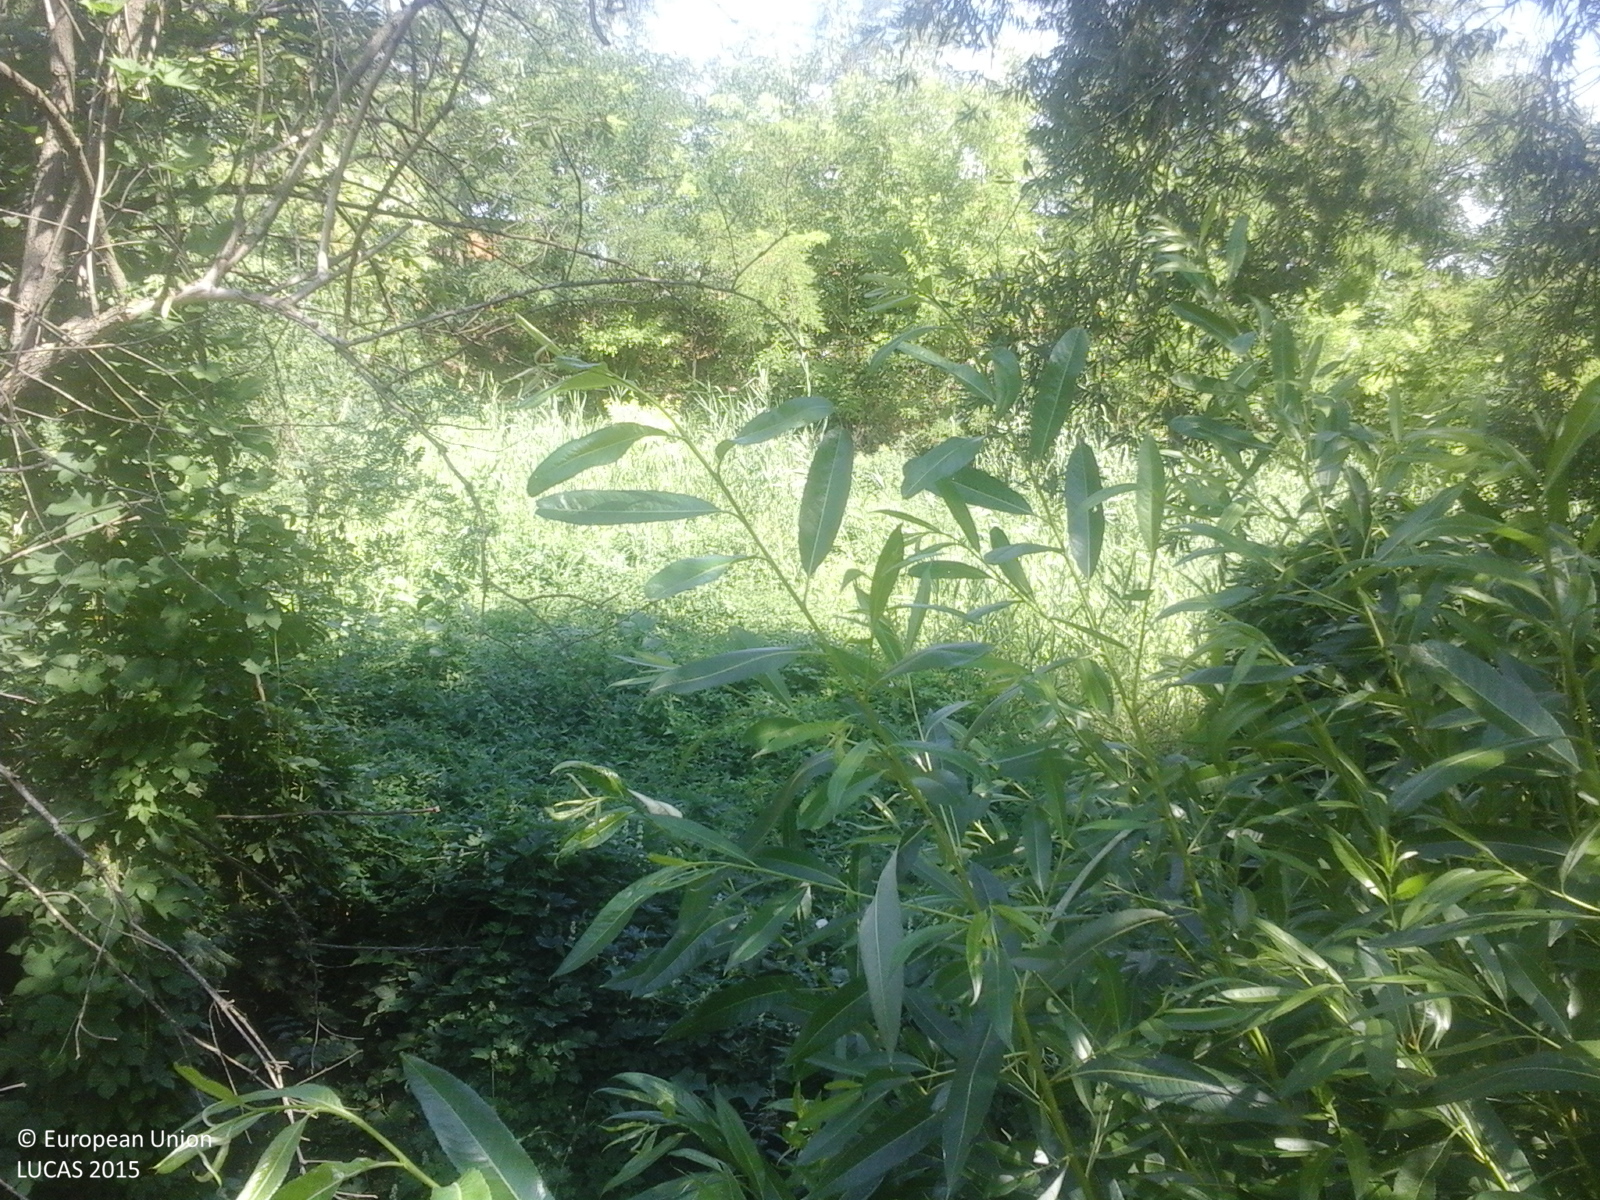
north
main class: Woodland
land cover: Broadleaved woodland
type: exotic forest
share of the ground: > 75 %
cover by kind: broadleaved forest trees 100 %
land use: Forestry
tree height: > 5 m
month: July
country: RO
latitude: 46.6793
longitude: 28.0530
